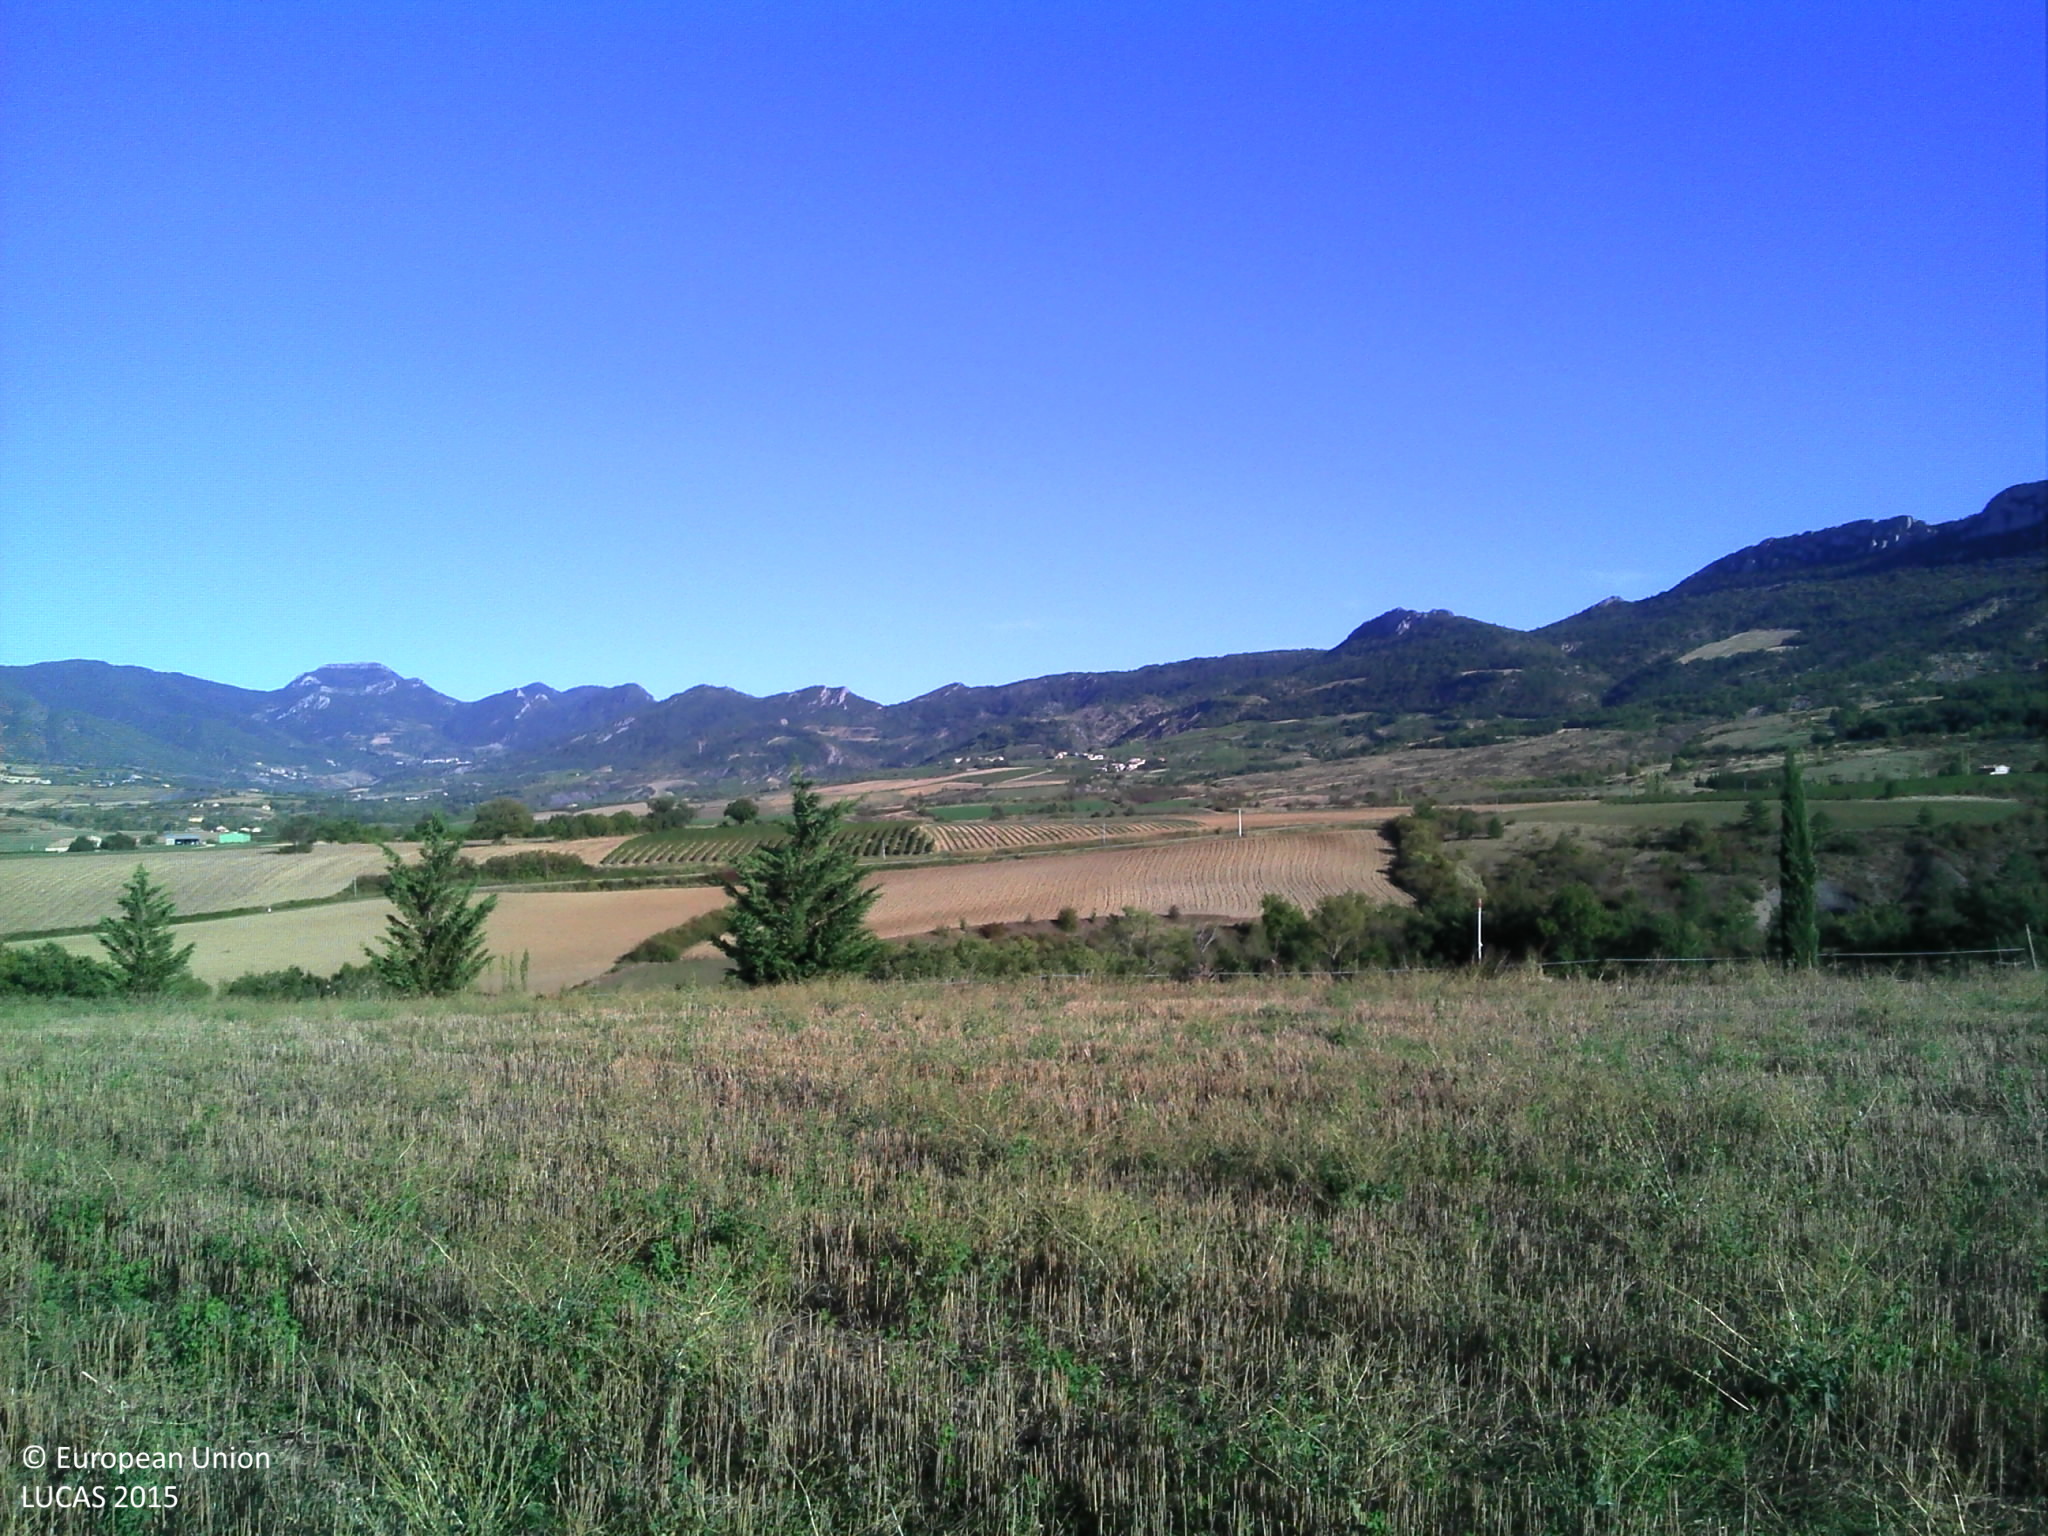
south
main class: Cropland
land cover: Common wheat
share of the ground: > 75 %
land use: Agriculture (excluding fallow land and kitchen gardens)
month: September
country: FR
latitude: 44.3335
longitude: 5.2794
